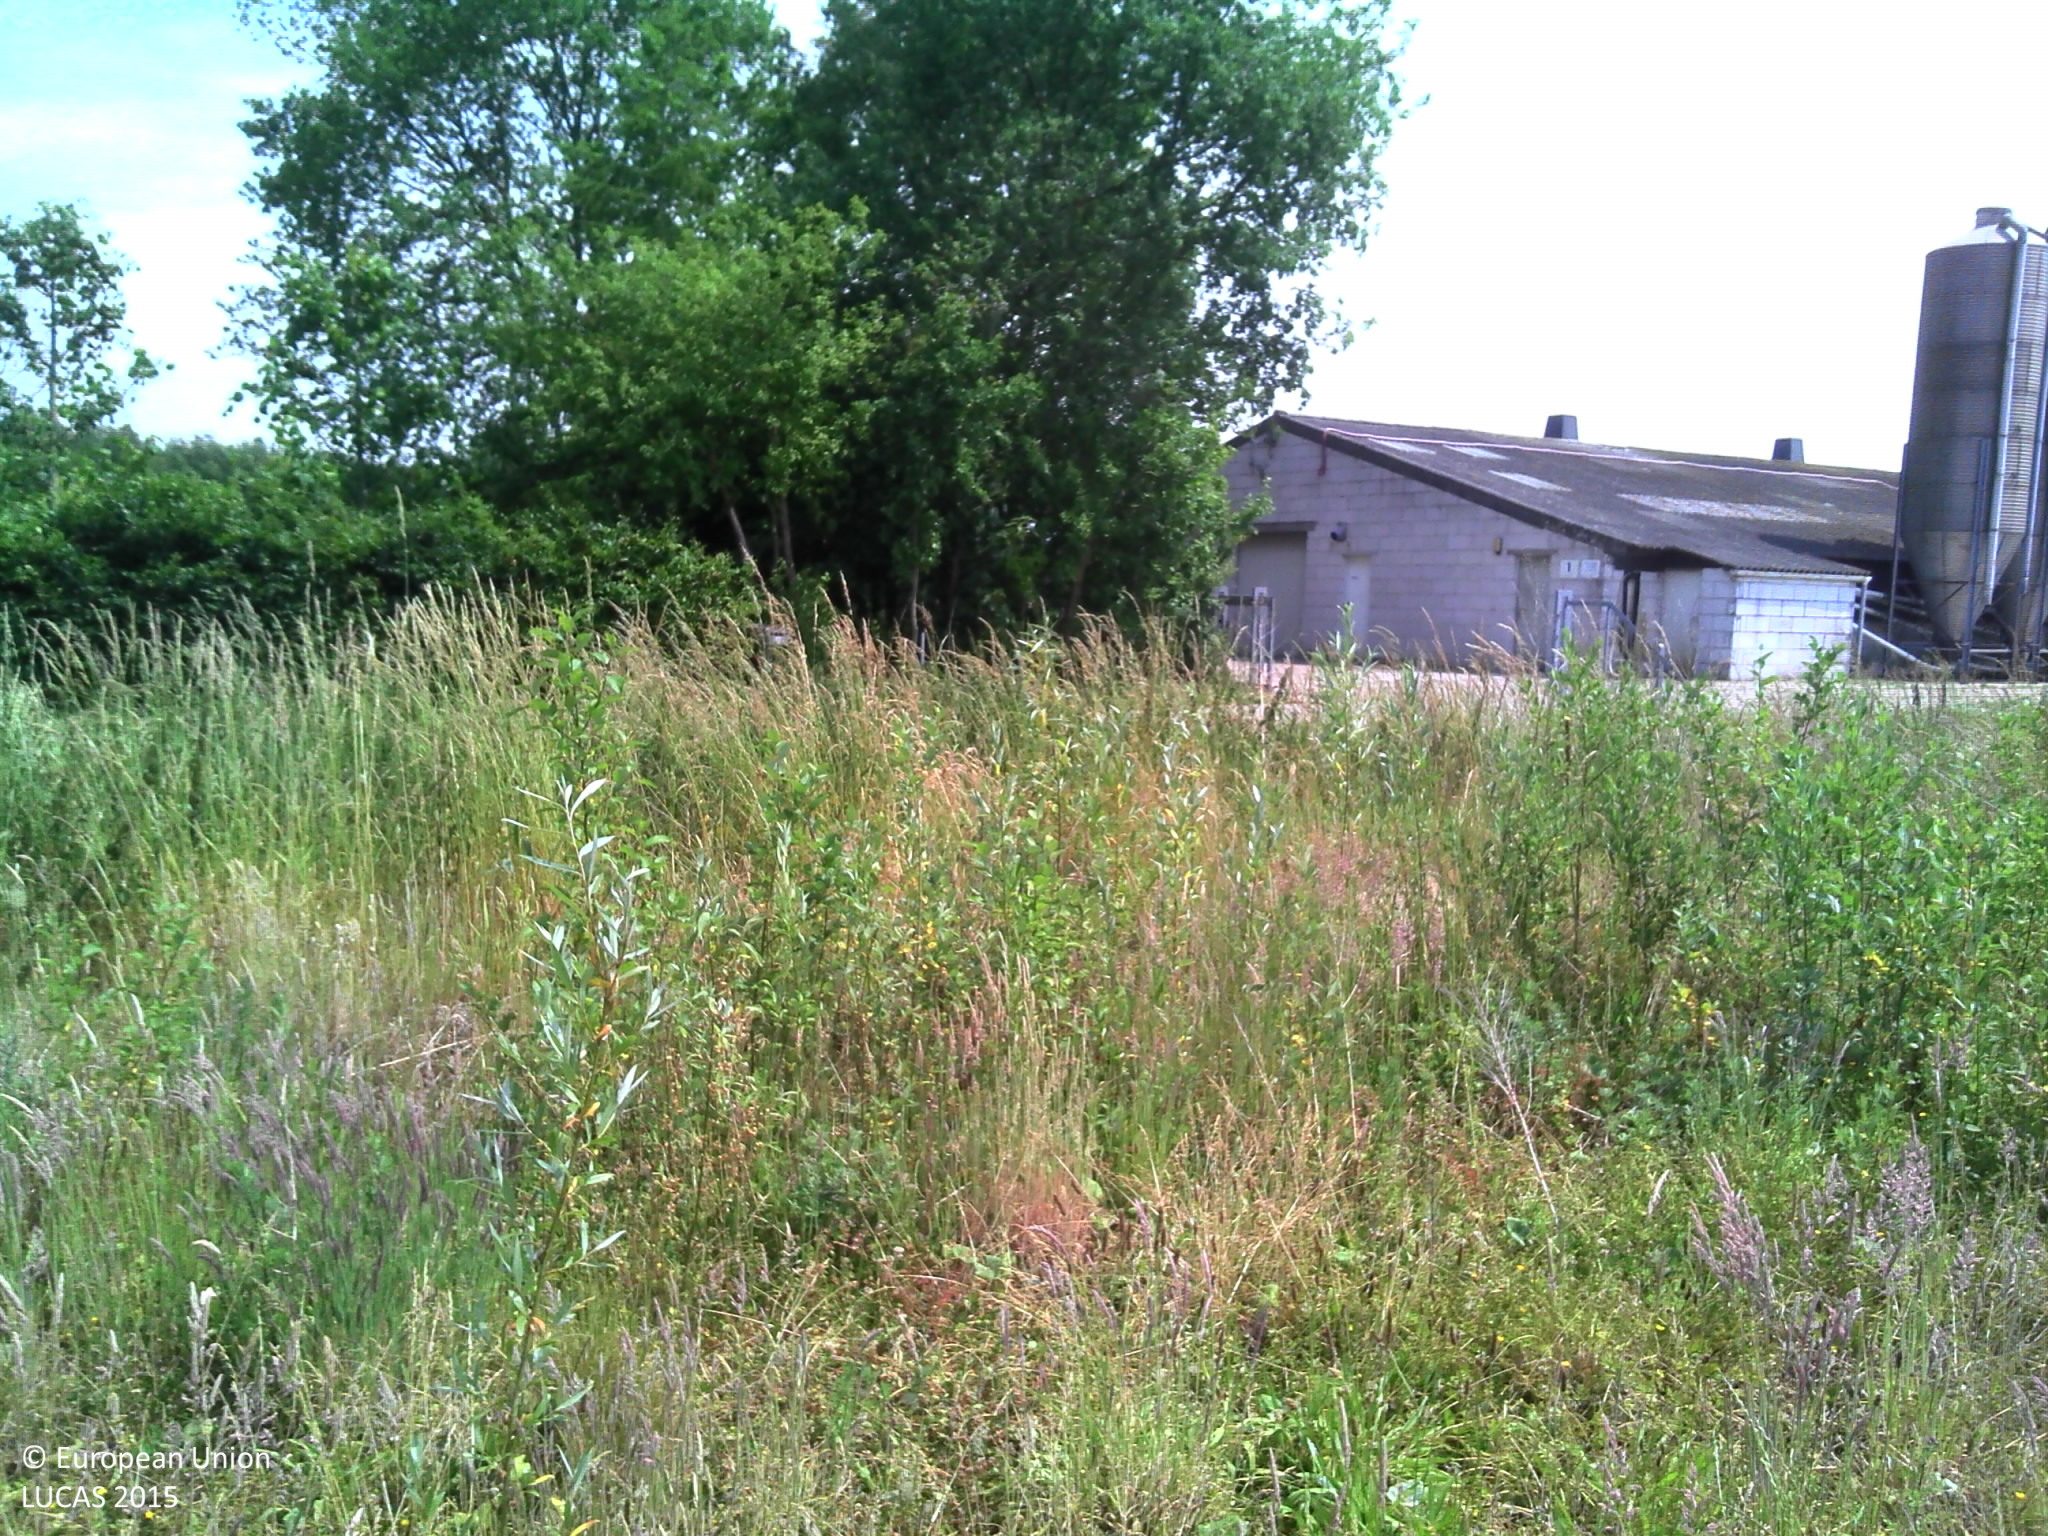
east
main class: Grassland
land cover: Grassland with sparse tree/shrub cover
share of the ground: > 75 %
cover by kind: herbaceous plants 95 %, broadleaved forest trees 5 %
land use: Agriculture (excluding fallow land and kitchen gardens)
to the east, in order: Grassland with sparse tree/shrub cover; Inland fresh running water; Artificial constructions in urban areas; Ditches and canals; Temporary grasslands; Tracks; Ditches and canals; Maize; Tracks; Ditches and canals; Broadleaved woodland
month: June
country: BE
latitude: 51.2204
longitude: 4.0811
